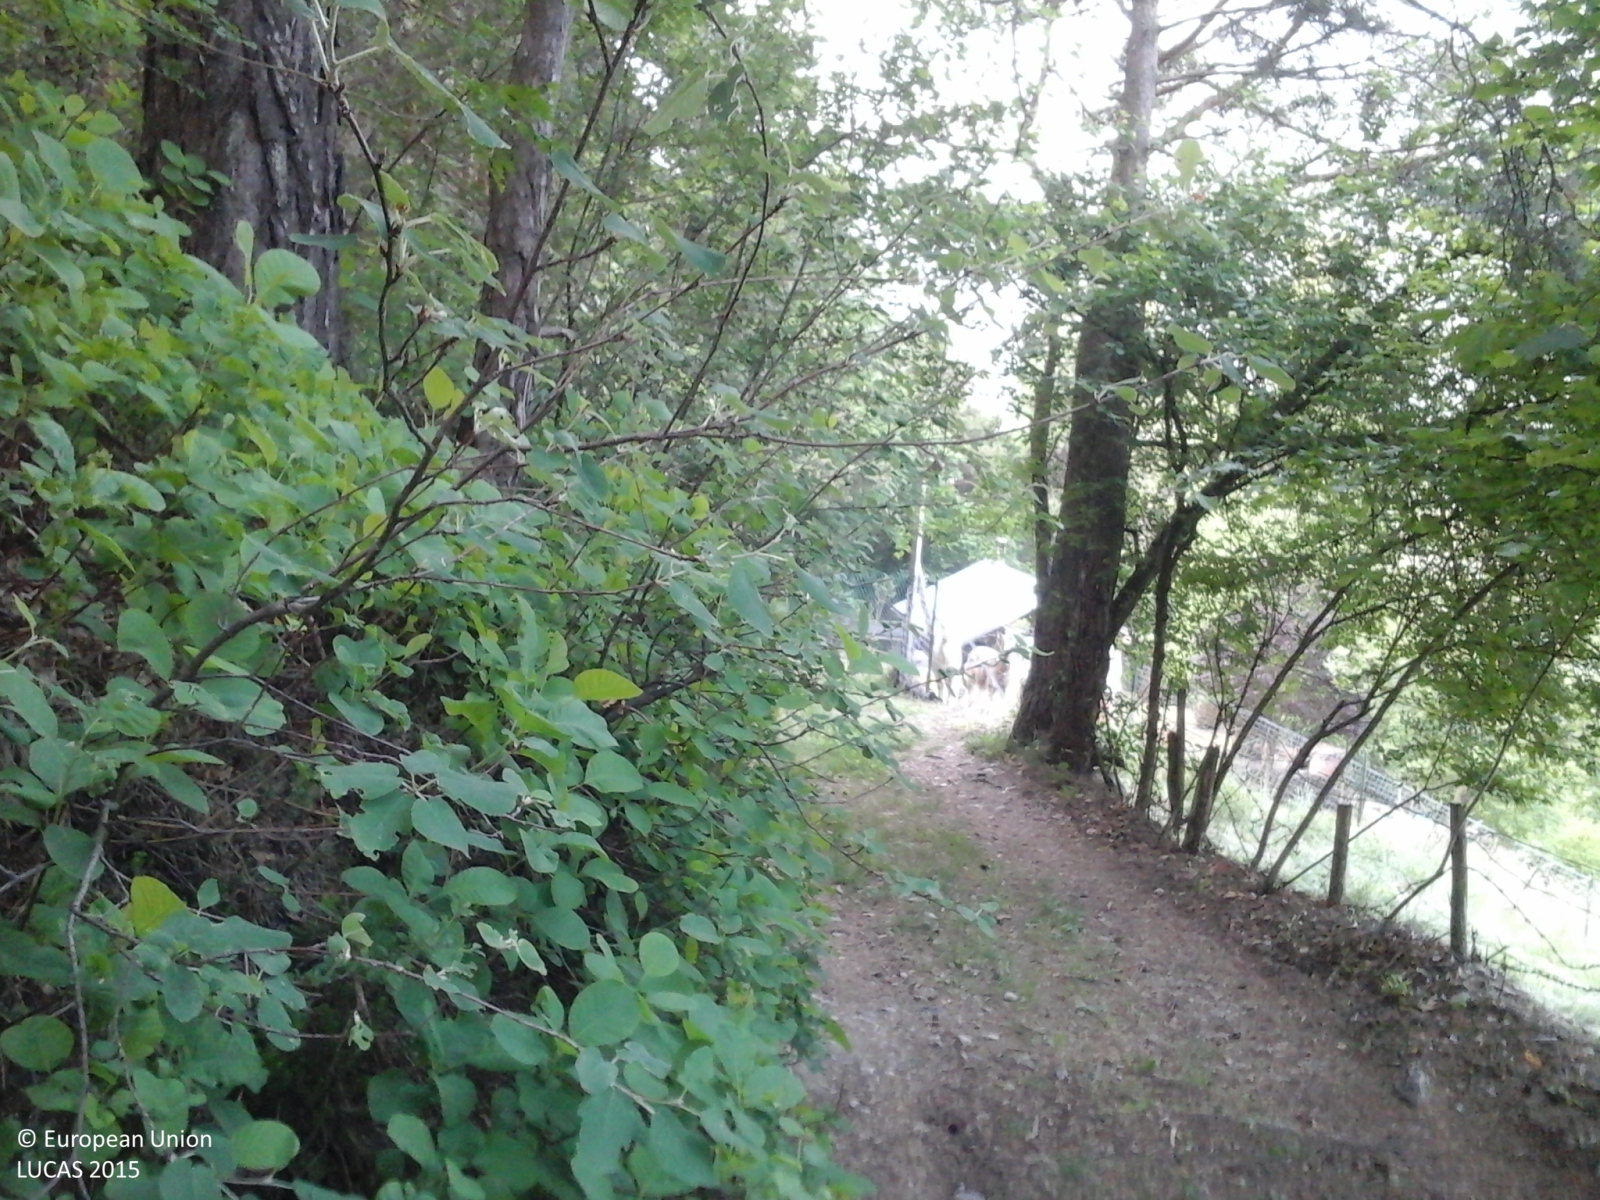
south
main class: Woodland
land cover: Pine dominated coniferous woodland
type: alpine coniferous forest
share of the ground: > 75 %
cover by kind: coniferous forest trees 95 %, broadleaved forest trees 5 %
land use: Forestry
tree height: > 5 m
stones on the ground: 10 - 25 %
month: June
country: IT
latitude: 46.0588
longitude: 10.9422
